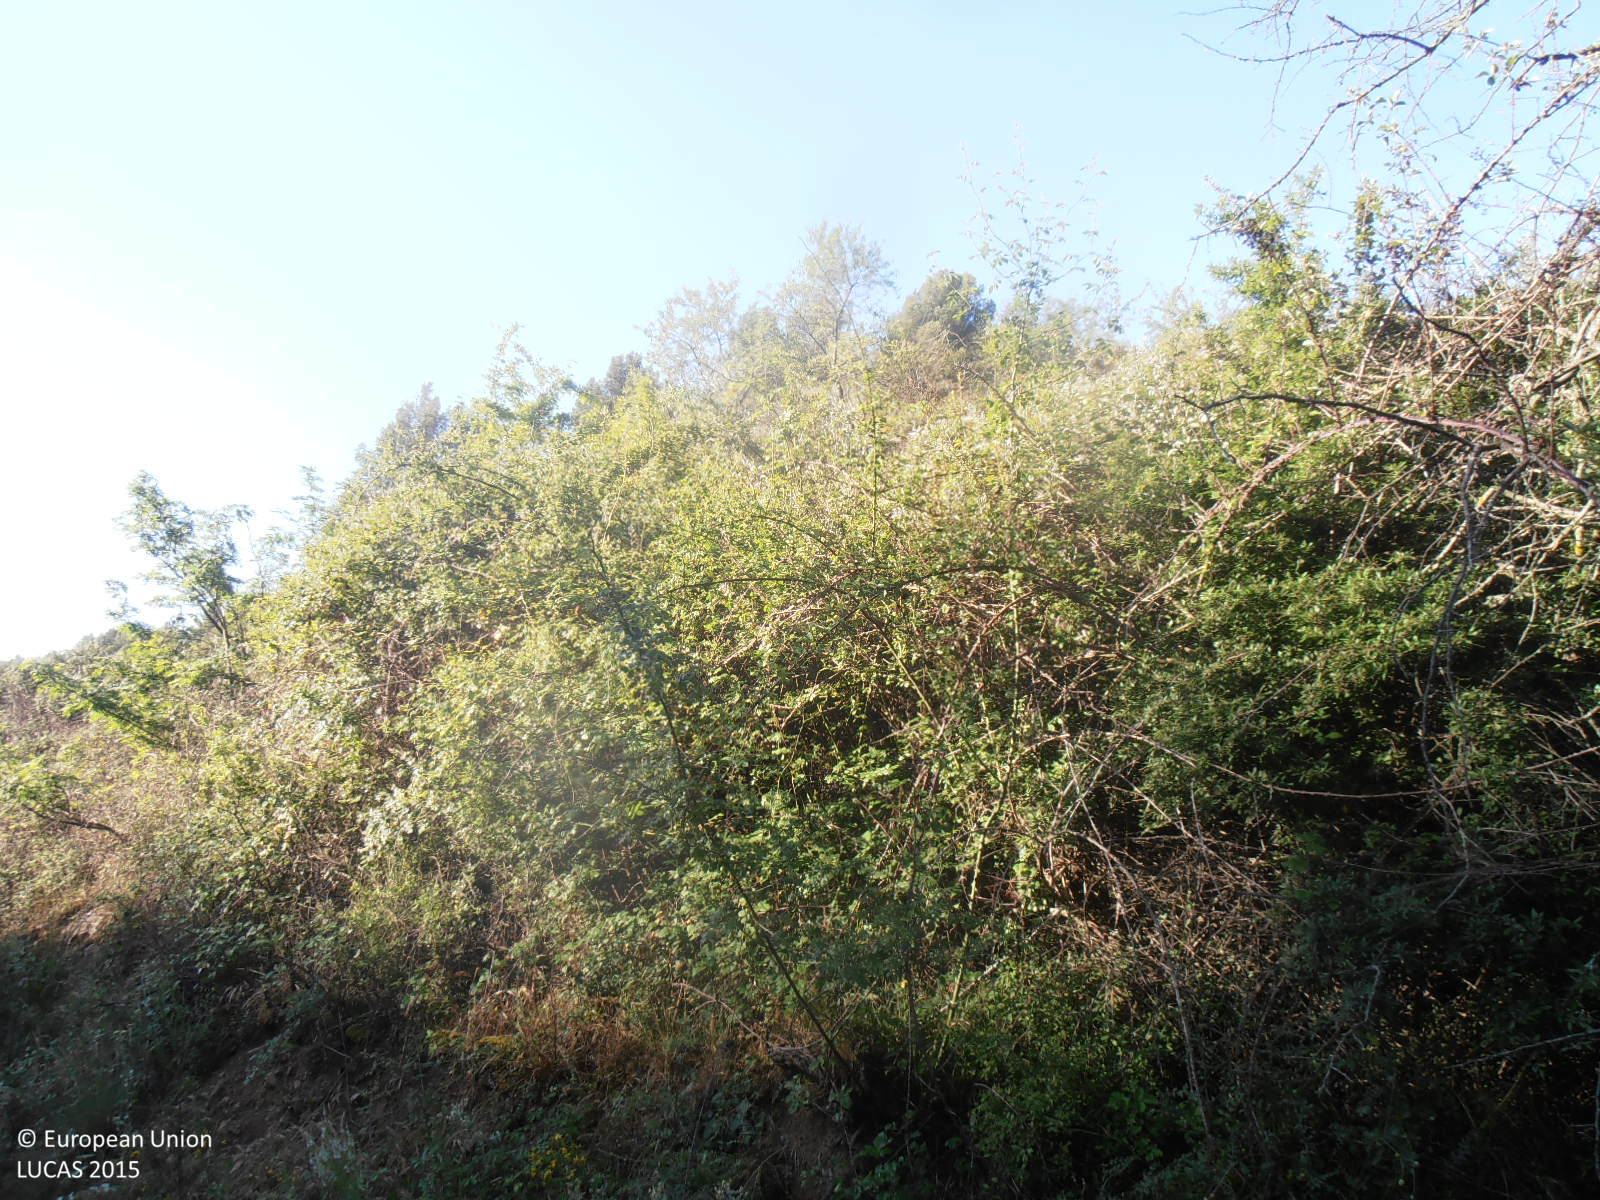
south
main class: Shrubland
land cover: Shrubland with sparse tree cover
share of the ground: > 75 %
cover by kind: shrubs 95 %, broadleaved forest trees 5 %
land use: Semi-natural and natural areas not in use
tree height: > 5 m
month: June
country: ES
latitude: 41.4067
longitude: -1.3998
